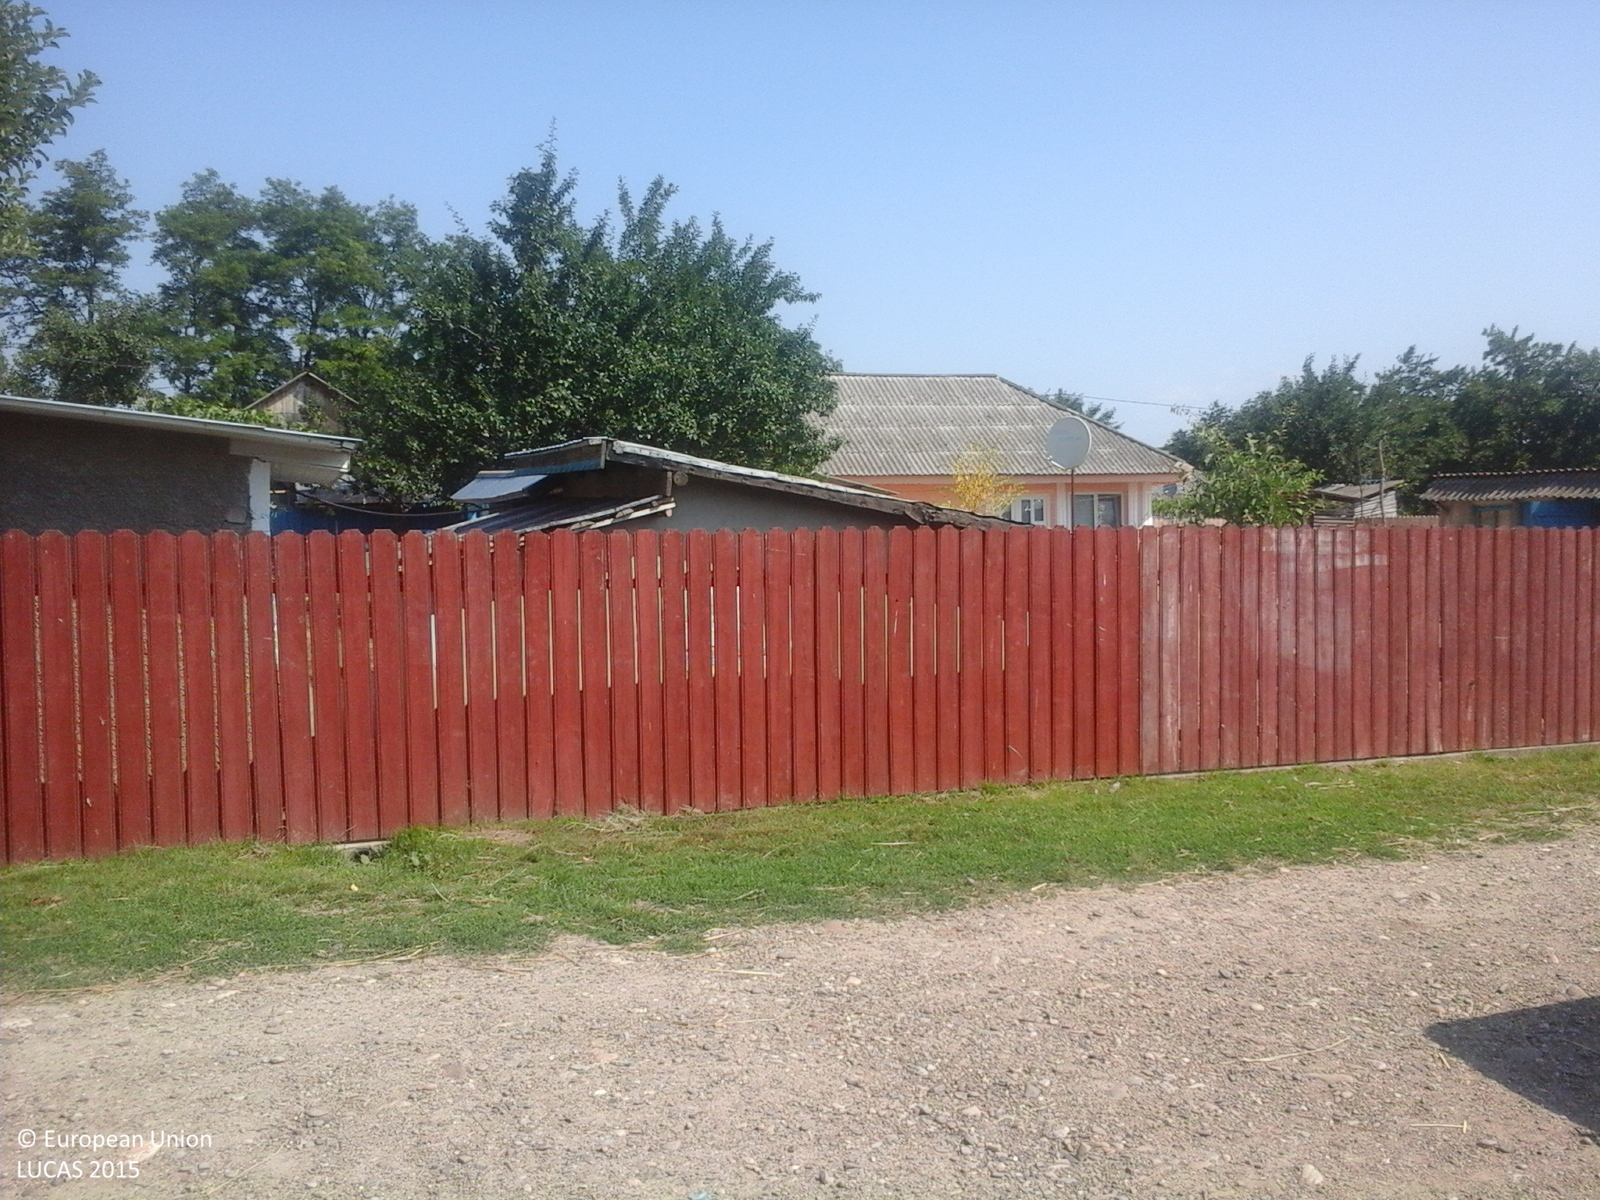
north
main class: Cropland
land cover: Vineyards
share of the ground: > 75 %
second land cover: Spontaneously vegetated surfaces
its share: 25 - 50 %
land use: Agriculture (excluding fallow land and kitchen gardens)
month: June
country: RO
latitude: 46.9034
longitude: 27.3727
